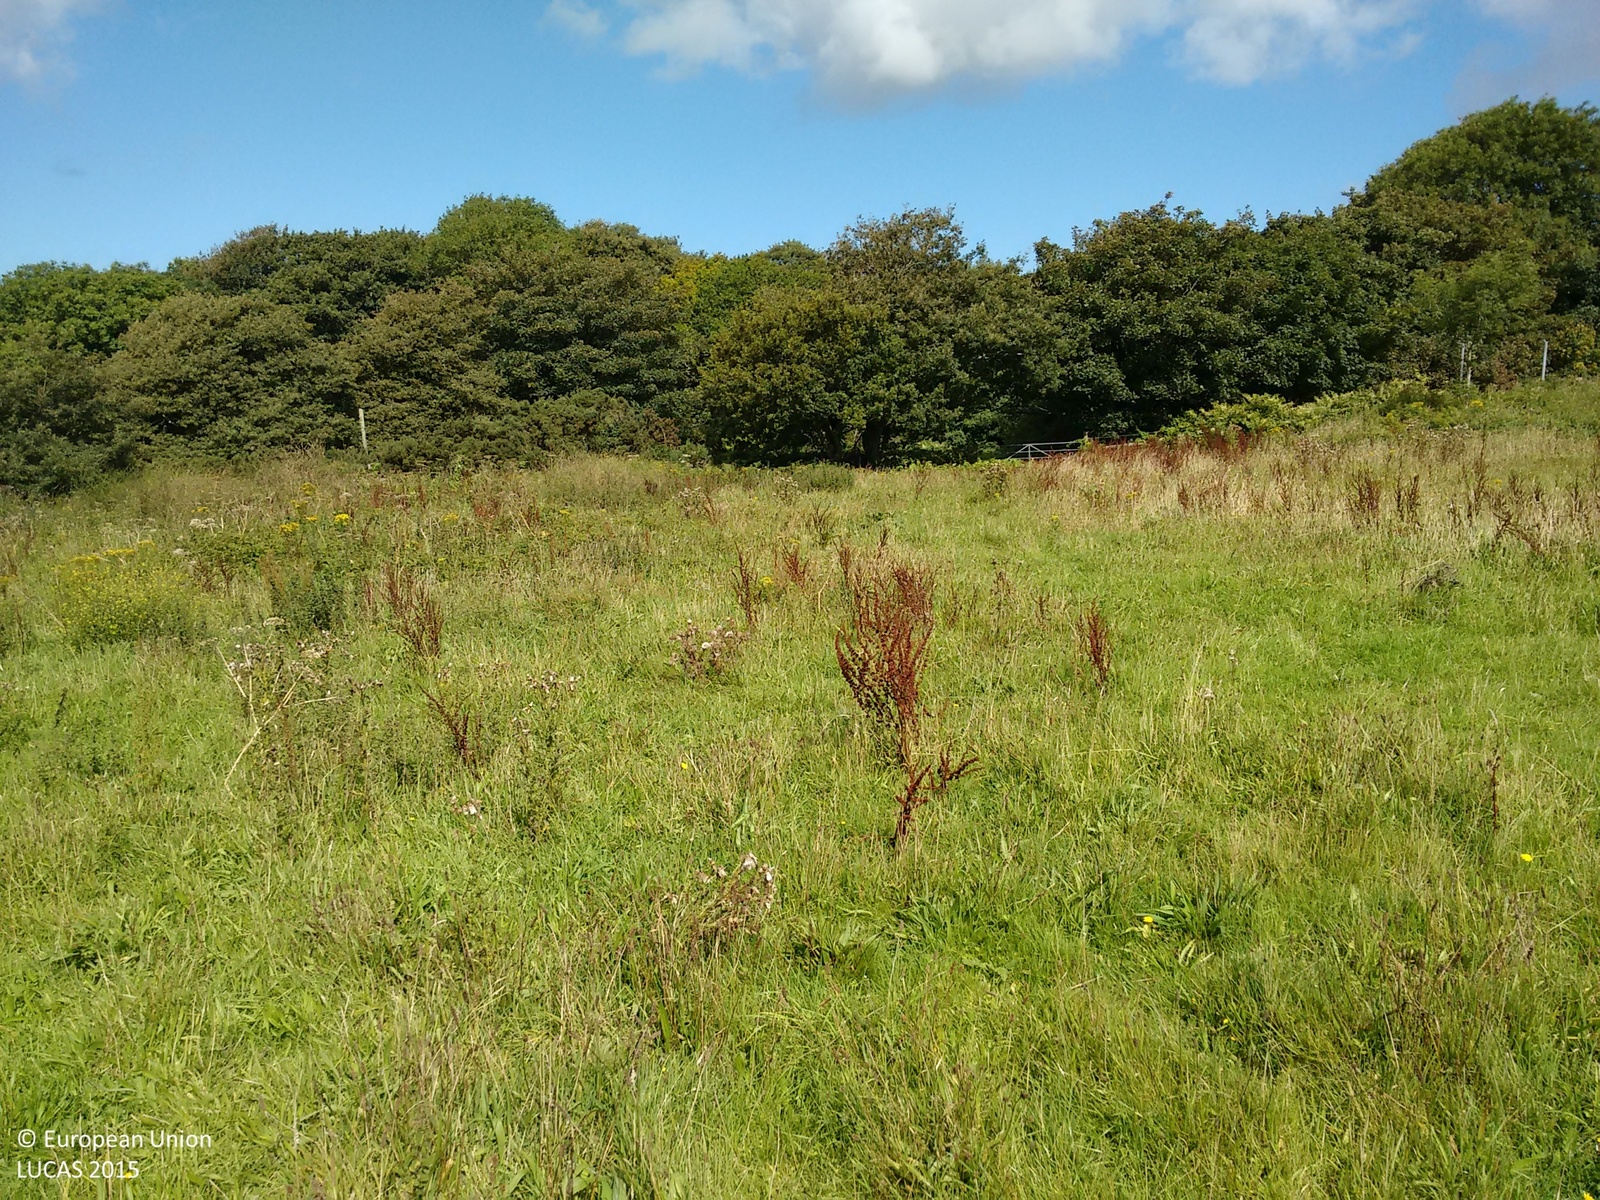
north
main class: Grassland
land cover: Grassland without tree/shrub cover
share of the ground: > 75 %
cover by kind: herbaceous plants 100 %
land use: Agriculture (excluding fallow land and kitchen gardens)
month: August
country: GB
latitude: 50.1882
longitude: -5.2910
